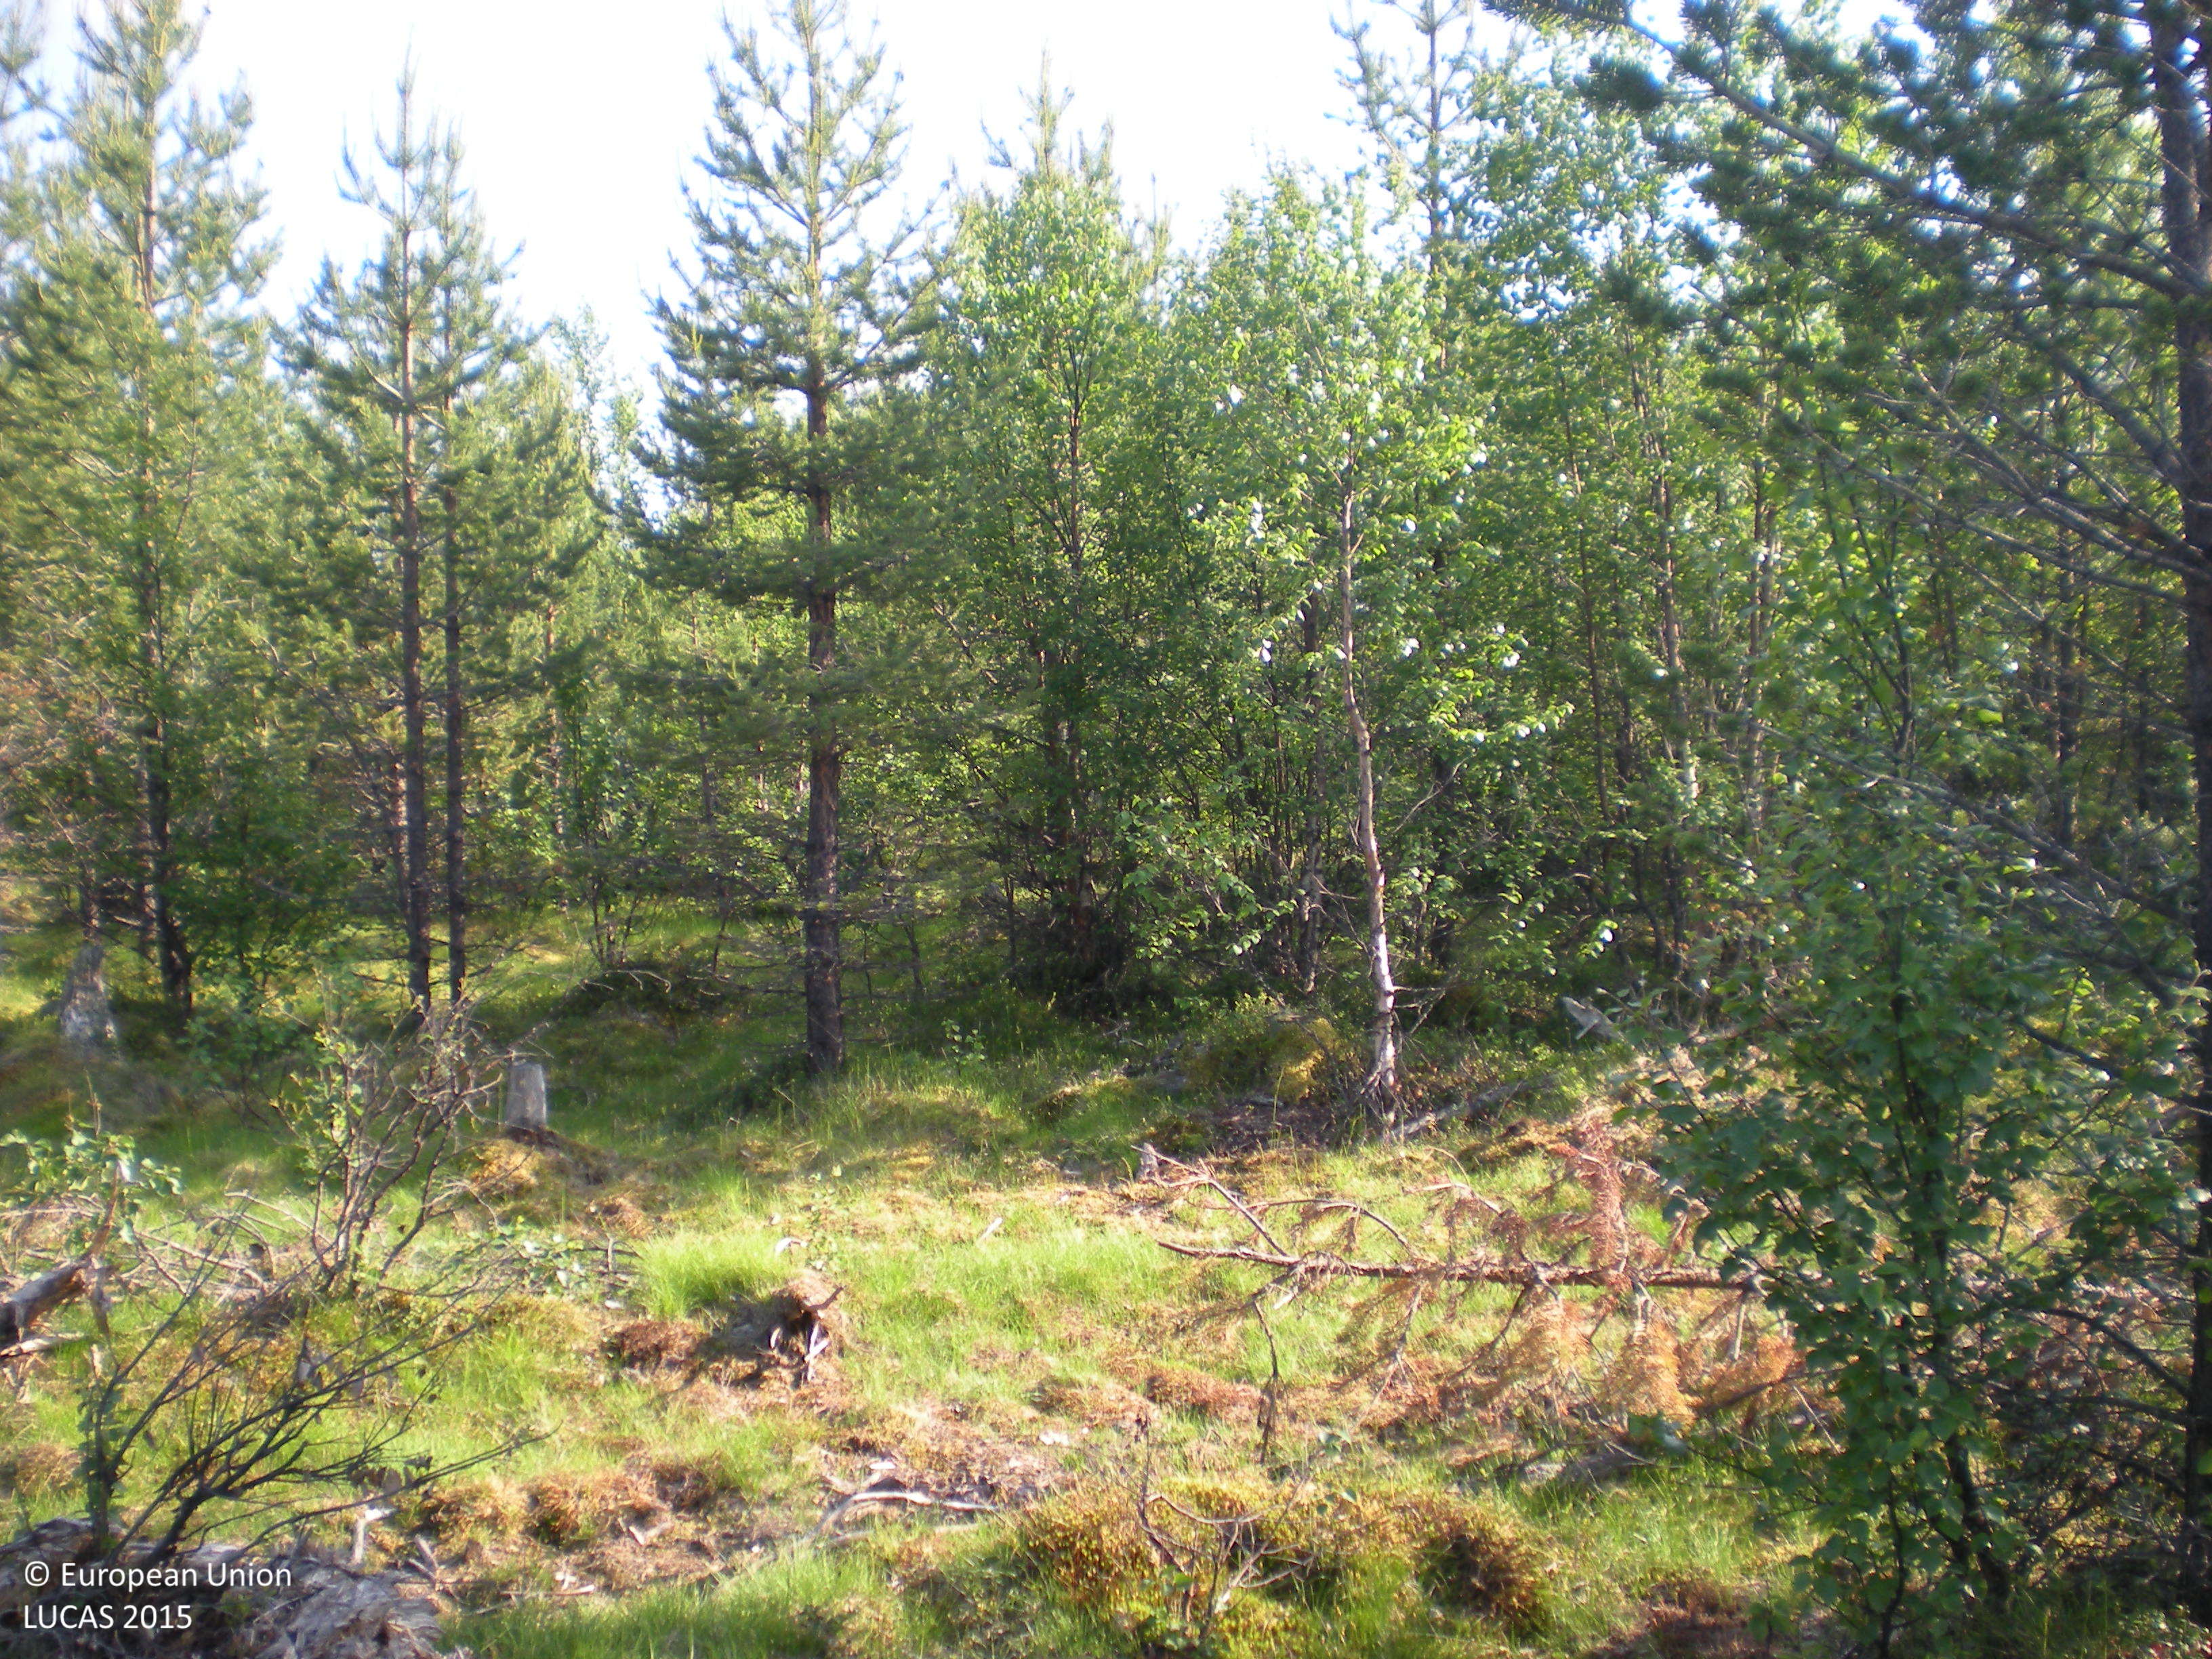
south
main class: Woodland
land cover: Pine dominated mixed woodland
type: boreal forest
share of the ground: 50 - 75 %
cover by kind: coniferous forest trees 30 %, herbaceous plants 30 %, broadleaved forest trees 25 %, shrubs 5 %, lichens and mosses 5 %, consolidated bare surface 5 %
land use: Forestry
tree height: < 5 m
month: July
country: SE
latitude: 65.4841
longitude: 17.6704
